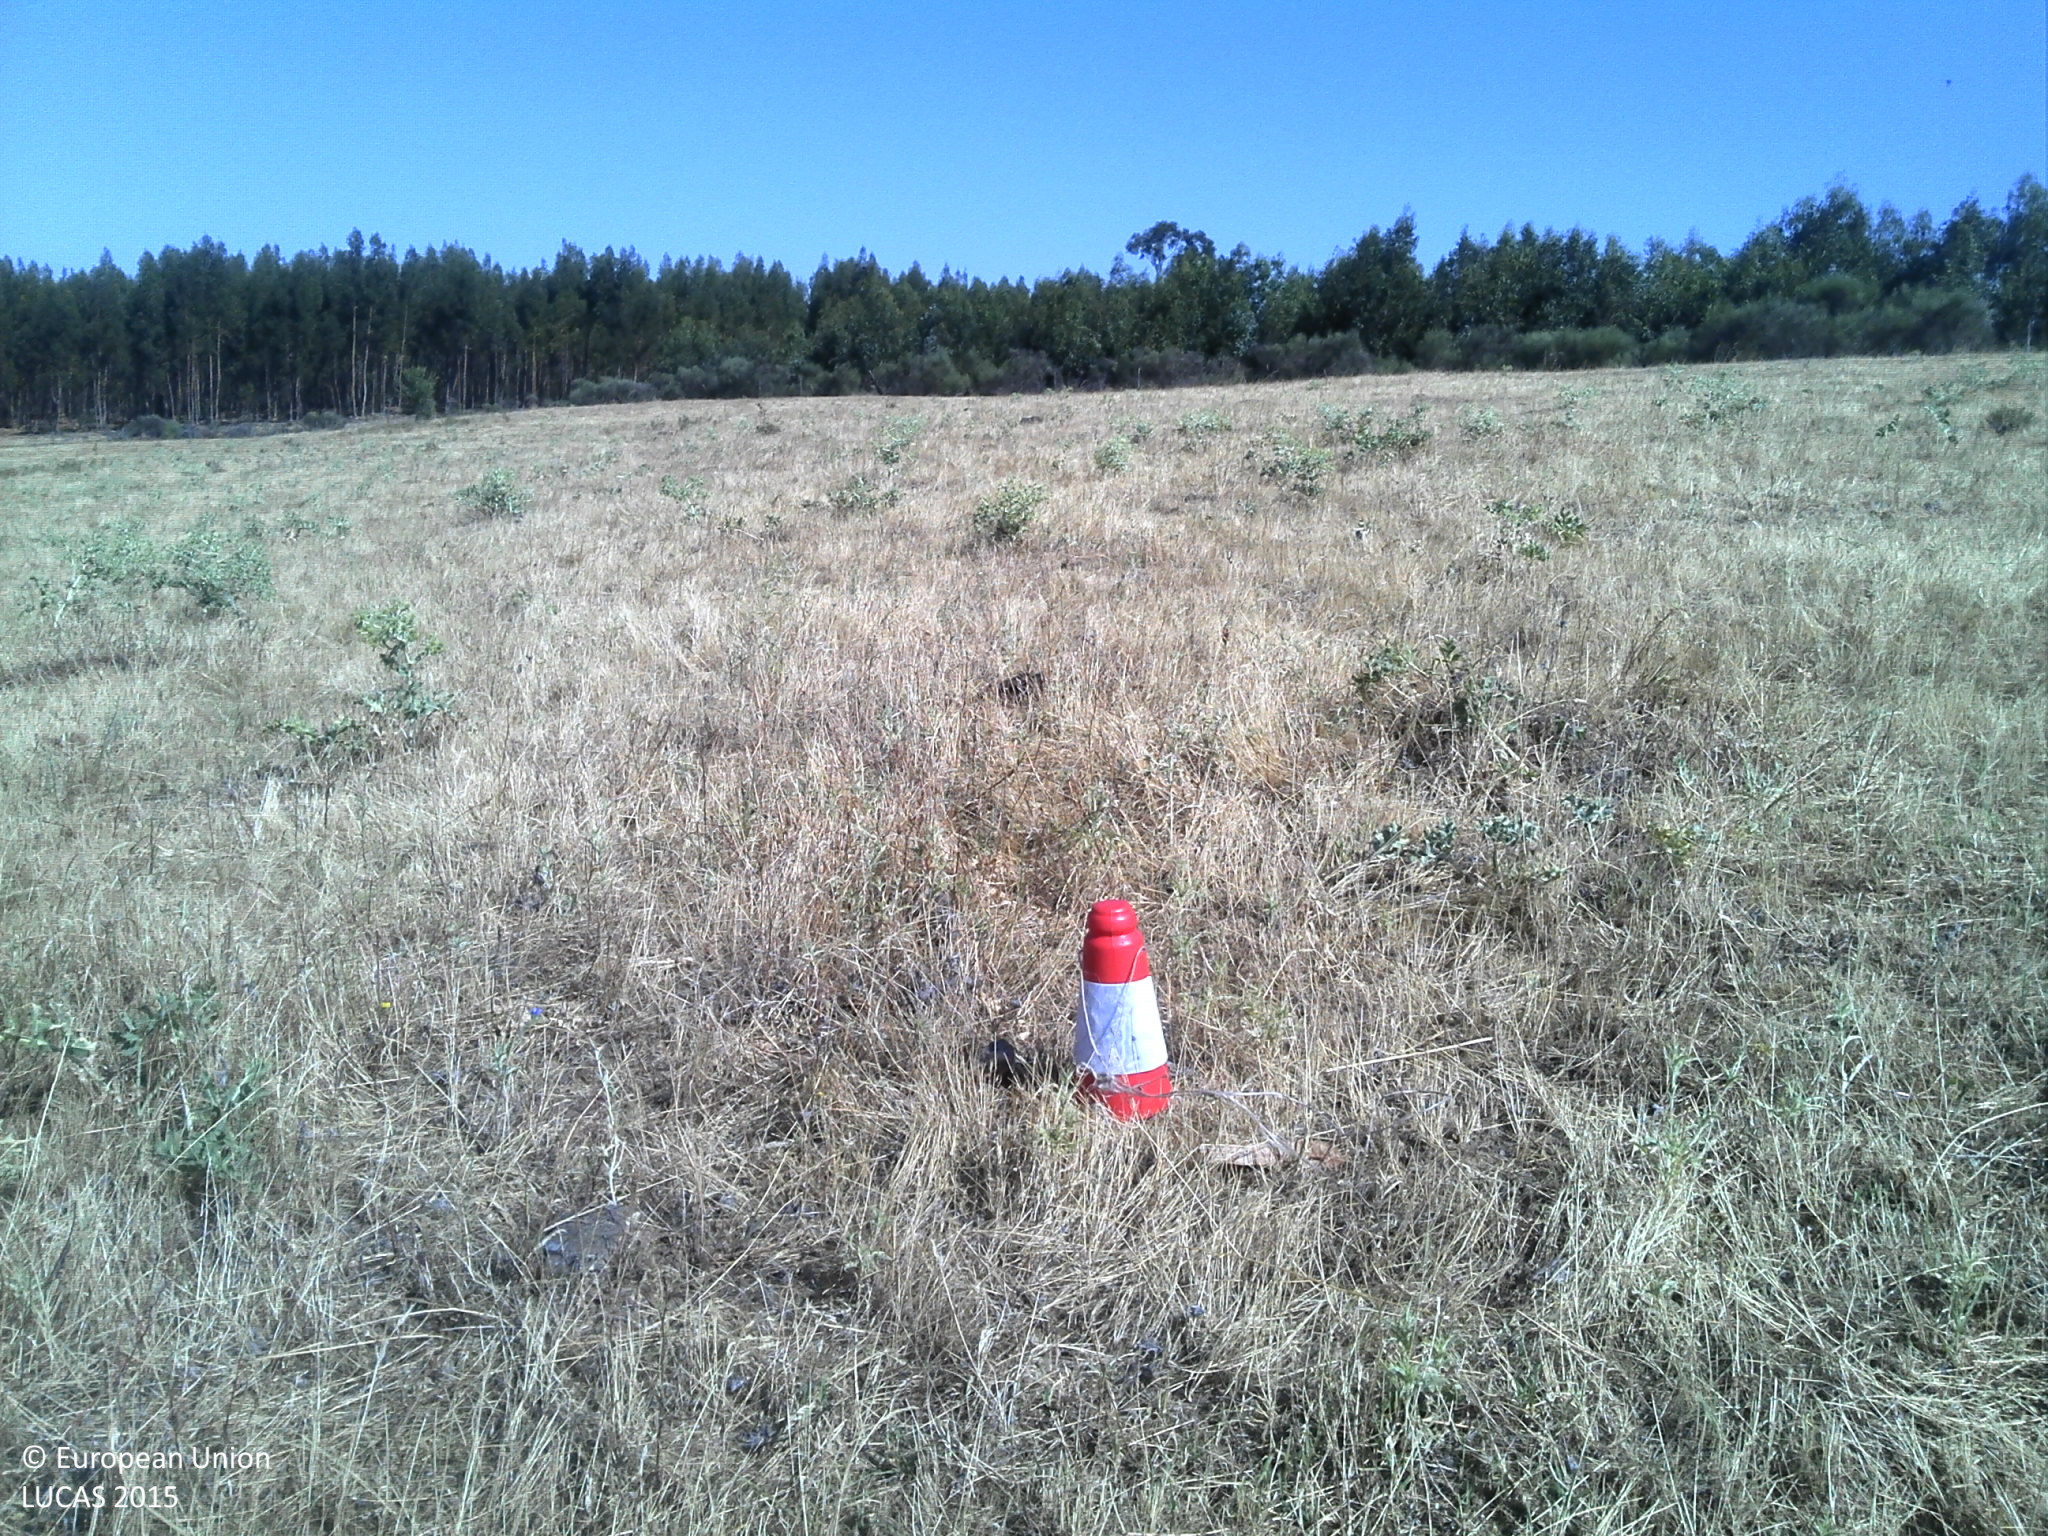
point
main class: Grassland
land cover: Grassland without tree/shrub cover
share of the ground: 50 - 75 %
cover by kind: herbaceous plants 75 %, unconsolidated bare surface 25 %
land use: Agriculture (excluding fallow land and kitchen gardens)
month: June
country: PT
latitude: 40.0551
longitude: -7.2475
